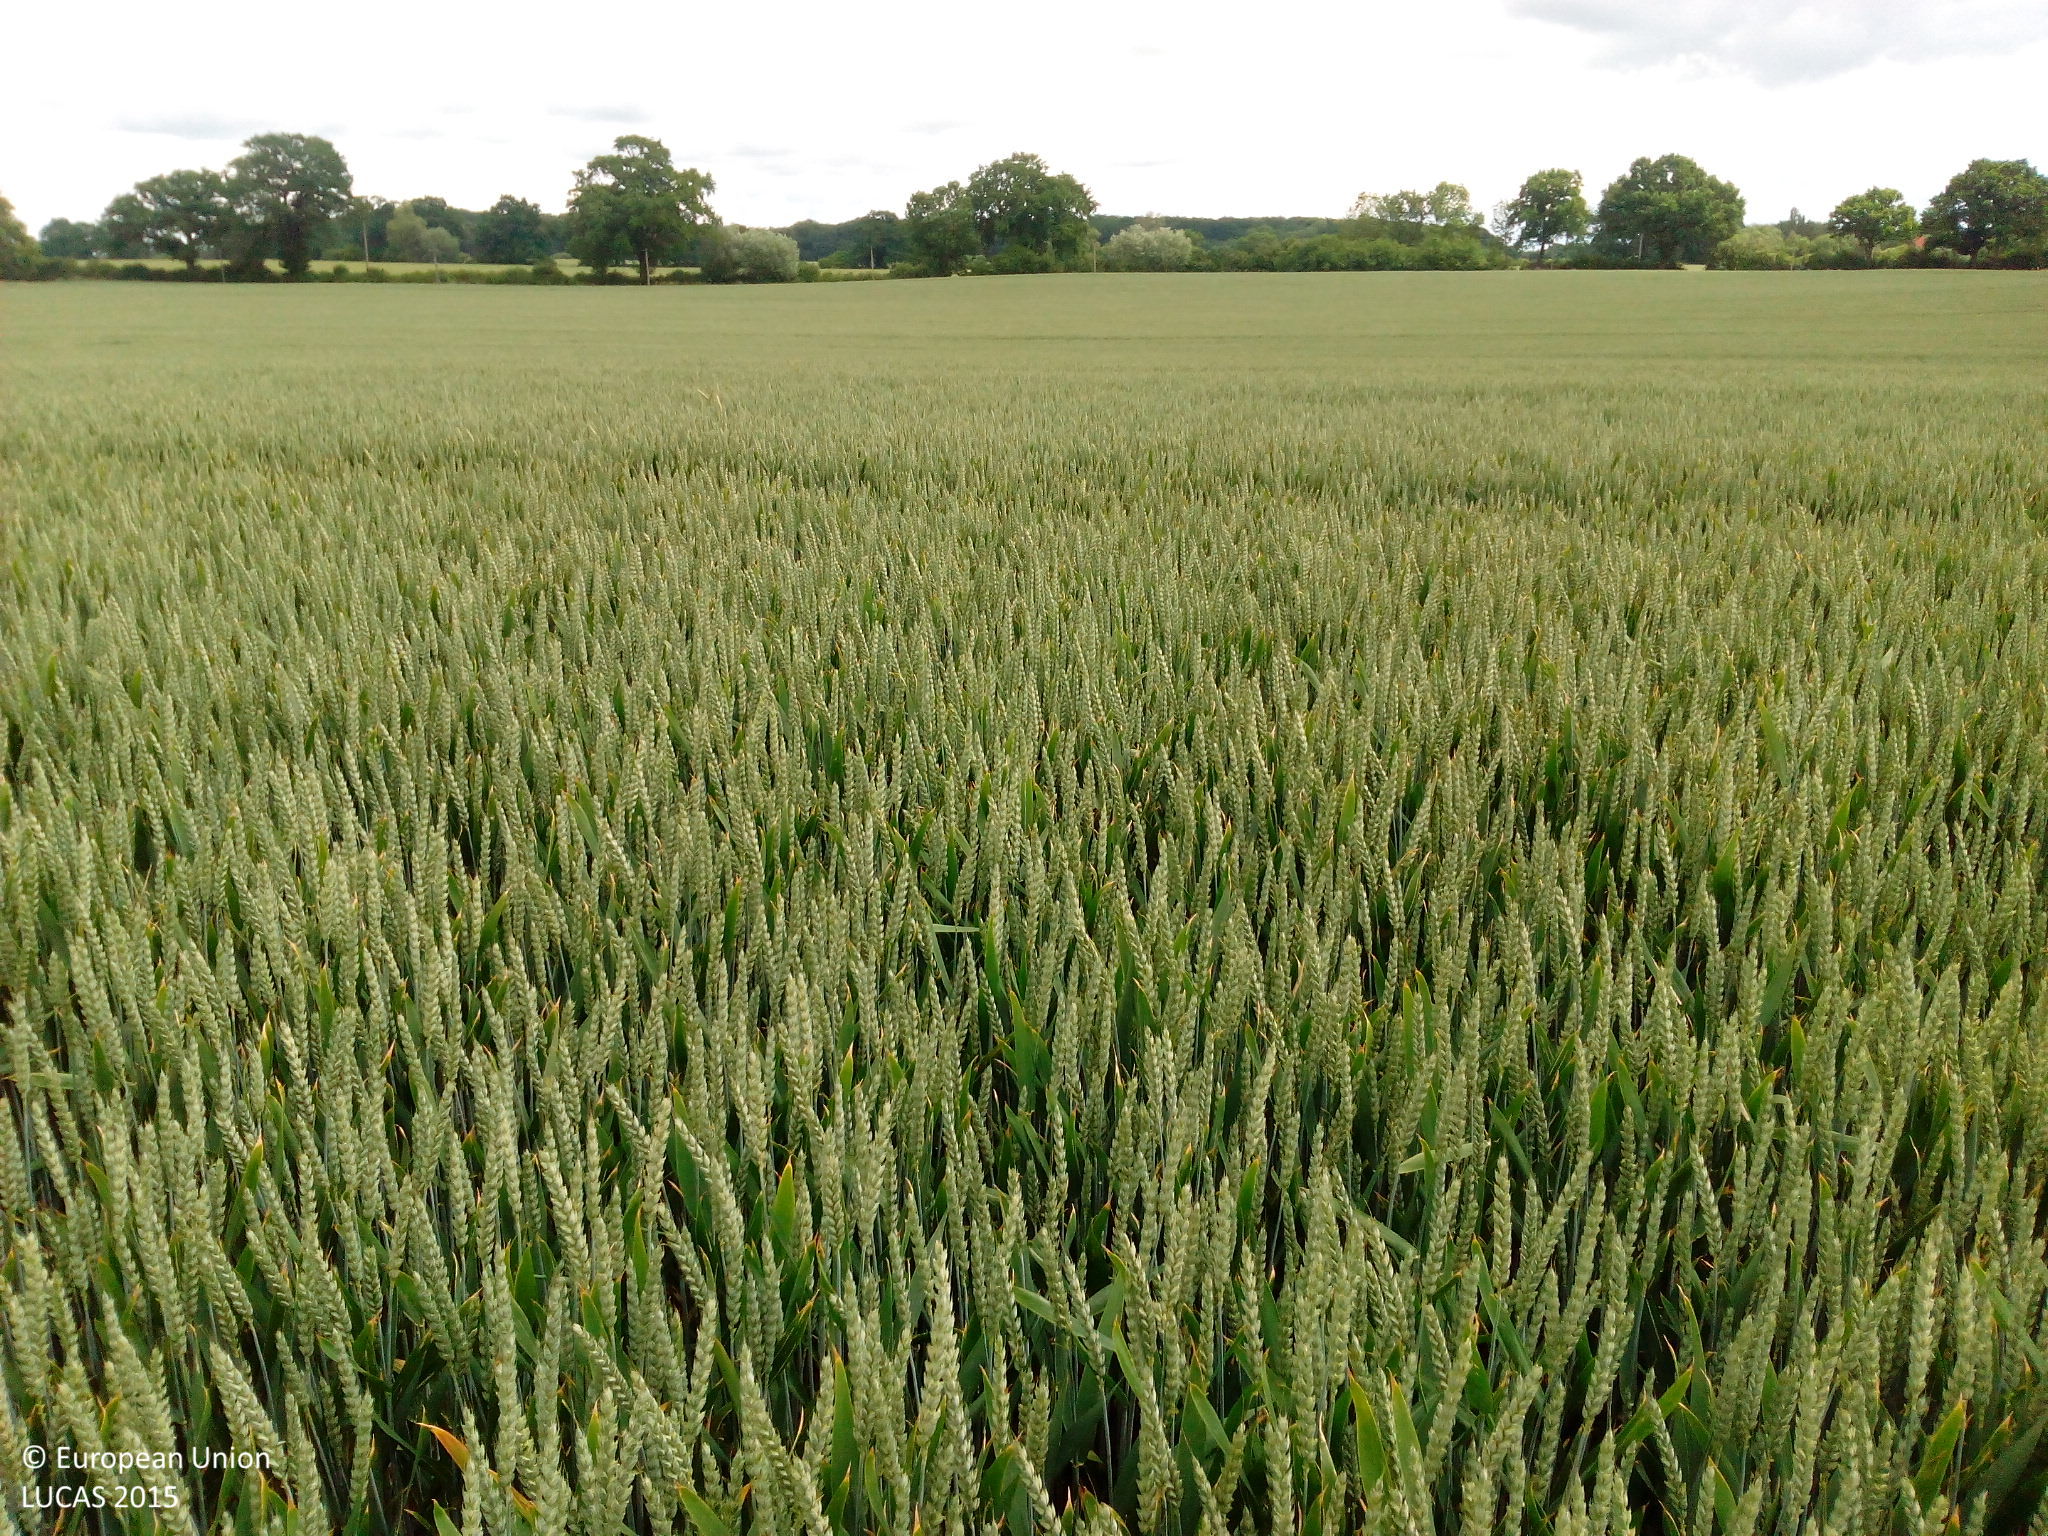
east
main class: Cropland
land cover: Common wheat
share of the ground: > 75 %
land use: Agriculture (excluding fallow land and kitchen gardens)
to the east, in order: Common wheat; Electric lines; Lines of trees; Paved roads, cycling and walking lanes
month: June
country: DE
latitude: 53.8100
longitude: 11.1384
